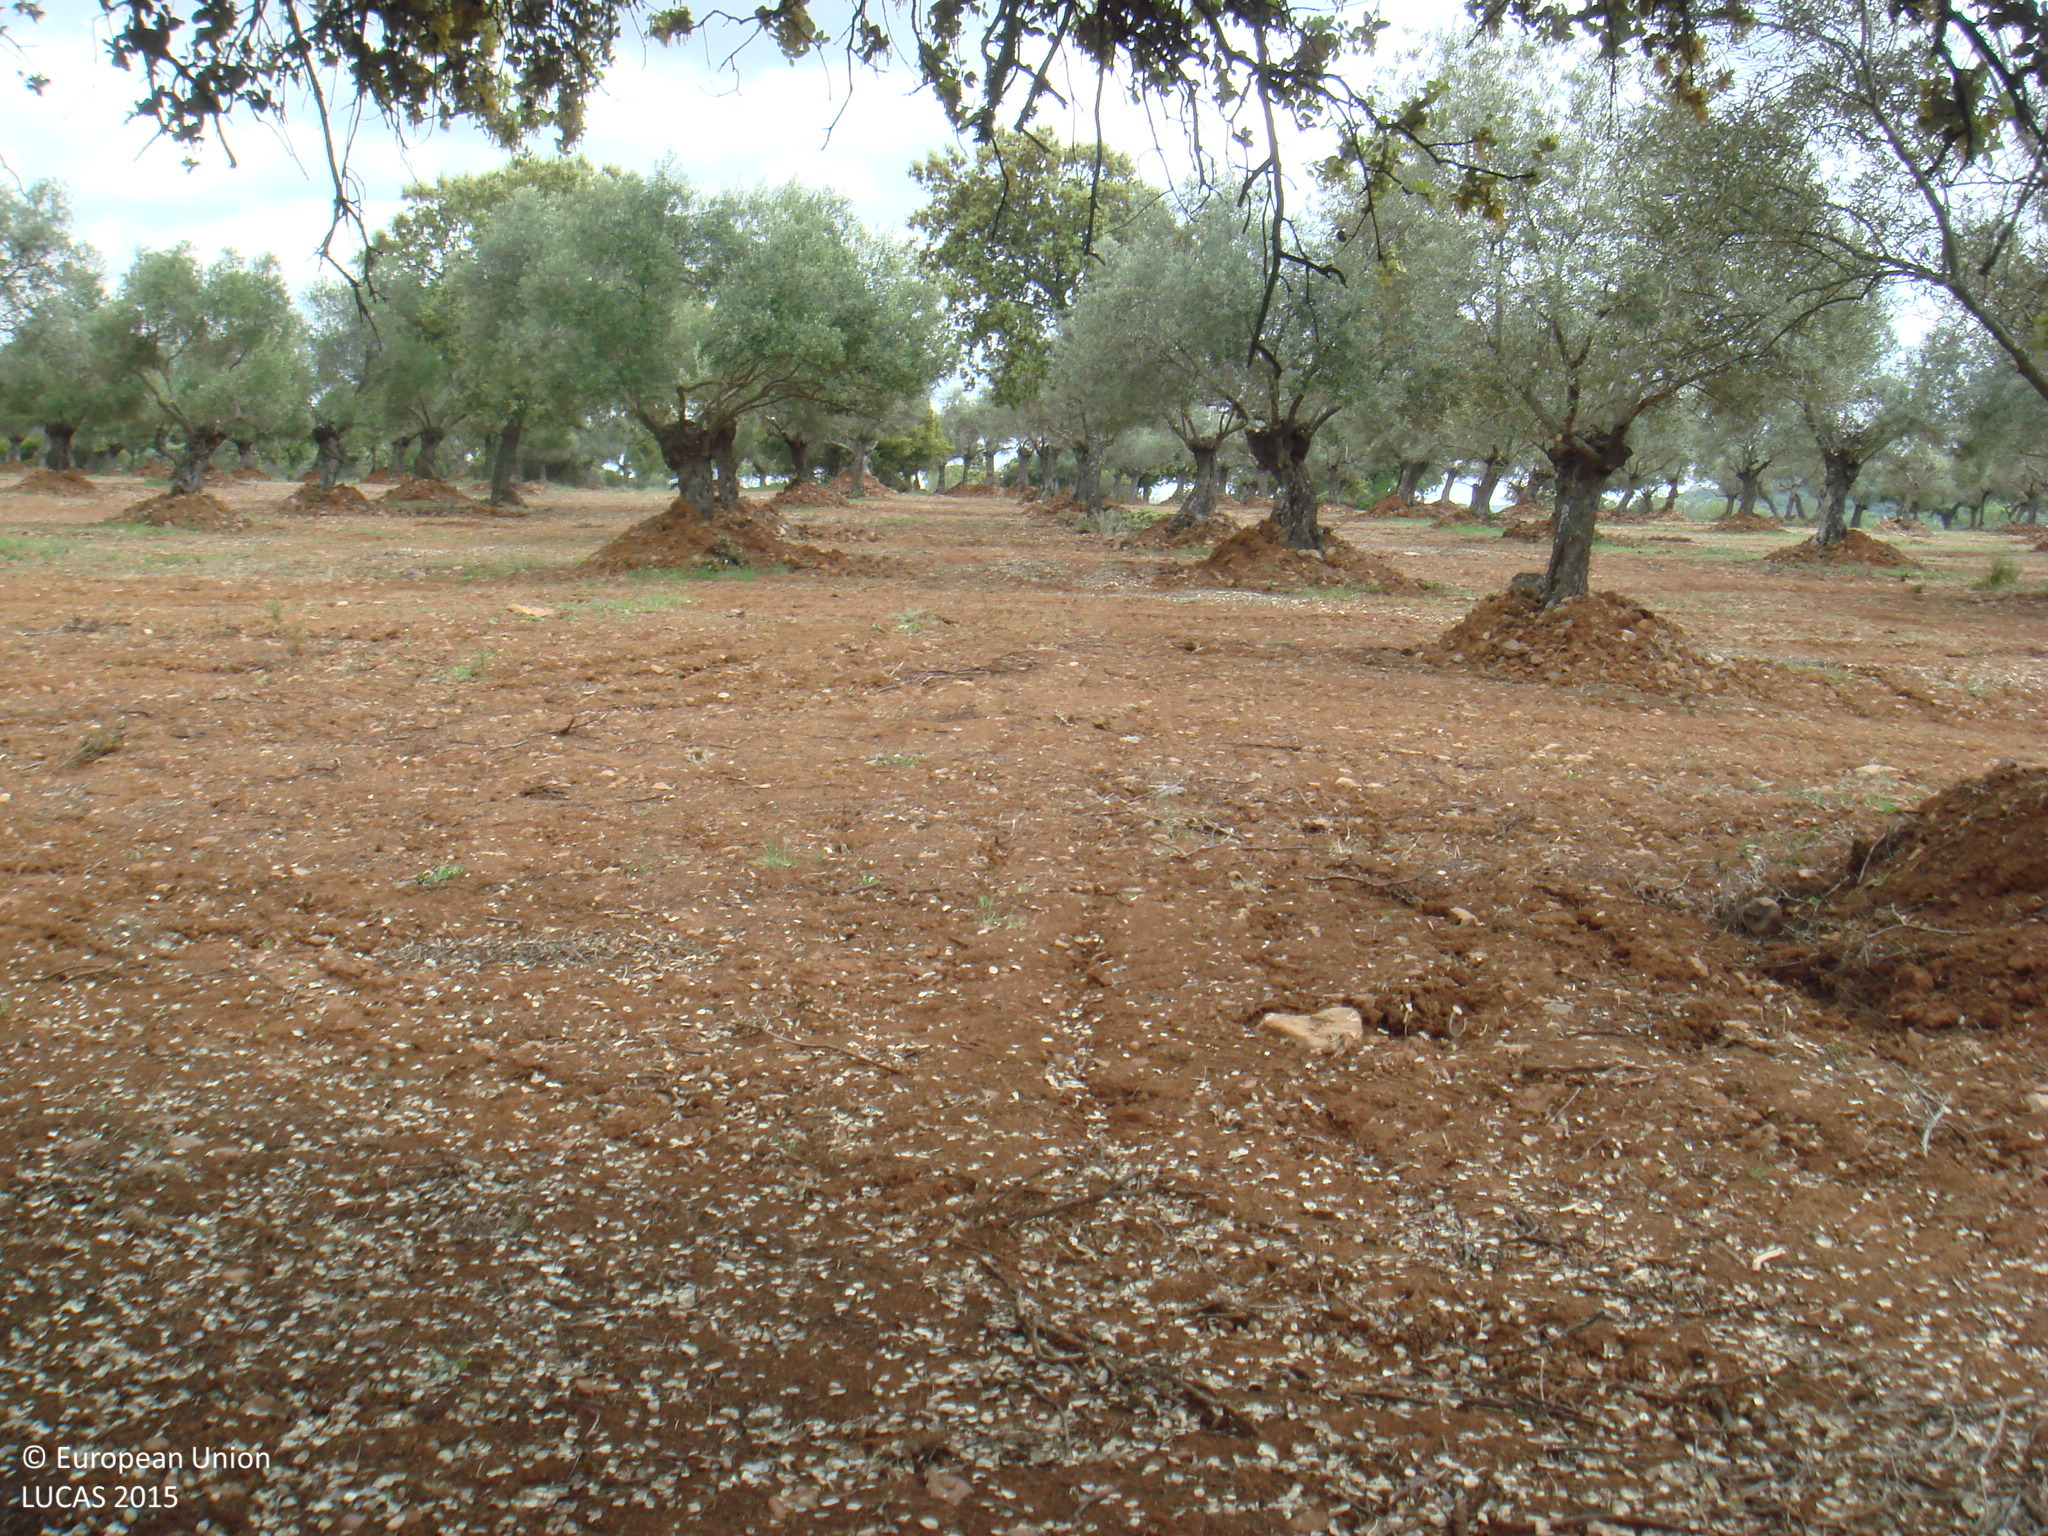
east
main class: Woodland
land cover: Broadleaved woodland
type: broadleaved evergreen forest
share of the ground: 25 - 50 %
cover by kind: broadleaved forest trees 40 %, shrubs 30 %, herbaceous plants 30 %
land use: Forestry
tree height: < 5 m
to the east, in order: Broadleaved woodland; Olive groves; Fences; Tracks; Fences; Grassland with sparse tree/shrub cover
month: April
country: ES
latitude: 38.2639
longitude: -5.1002
